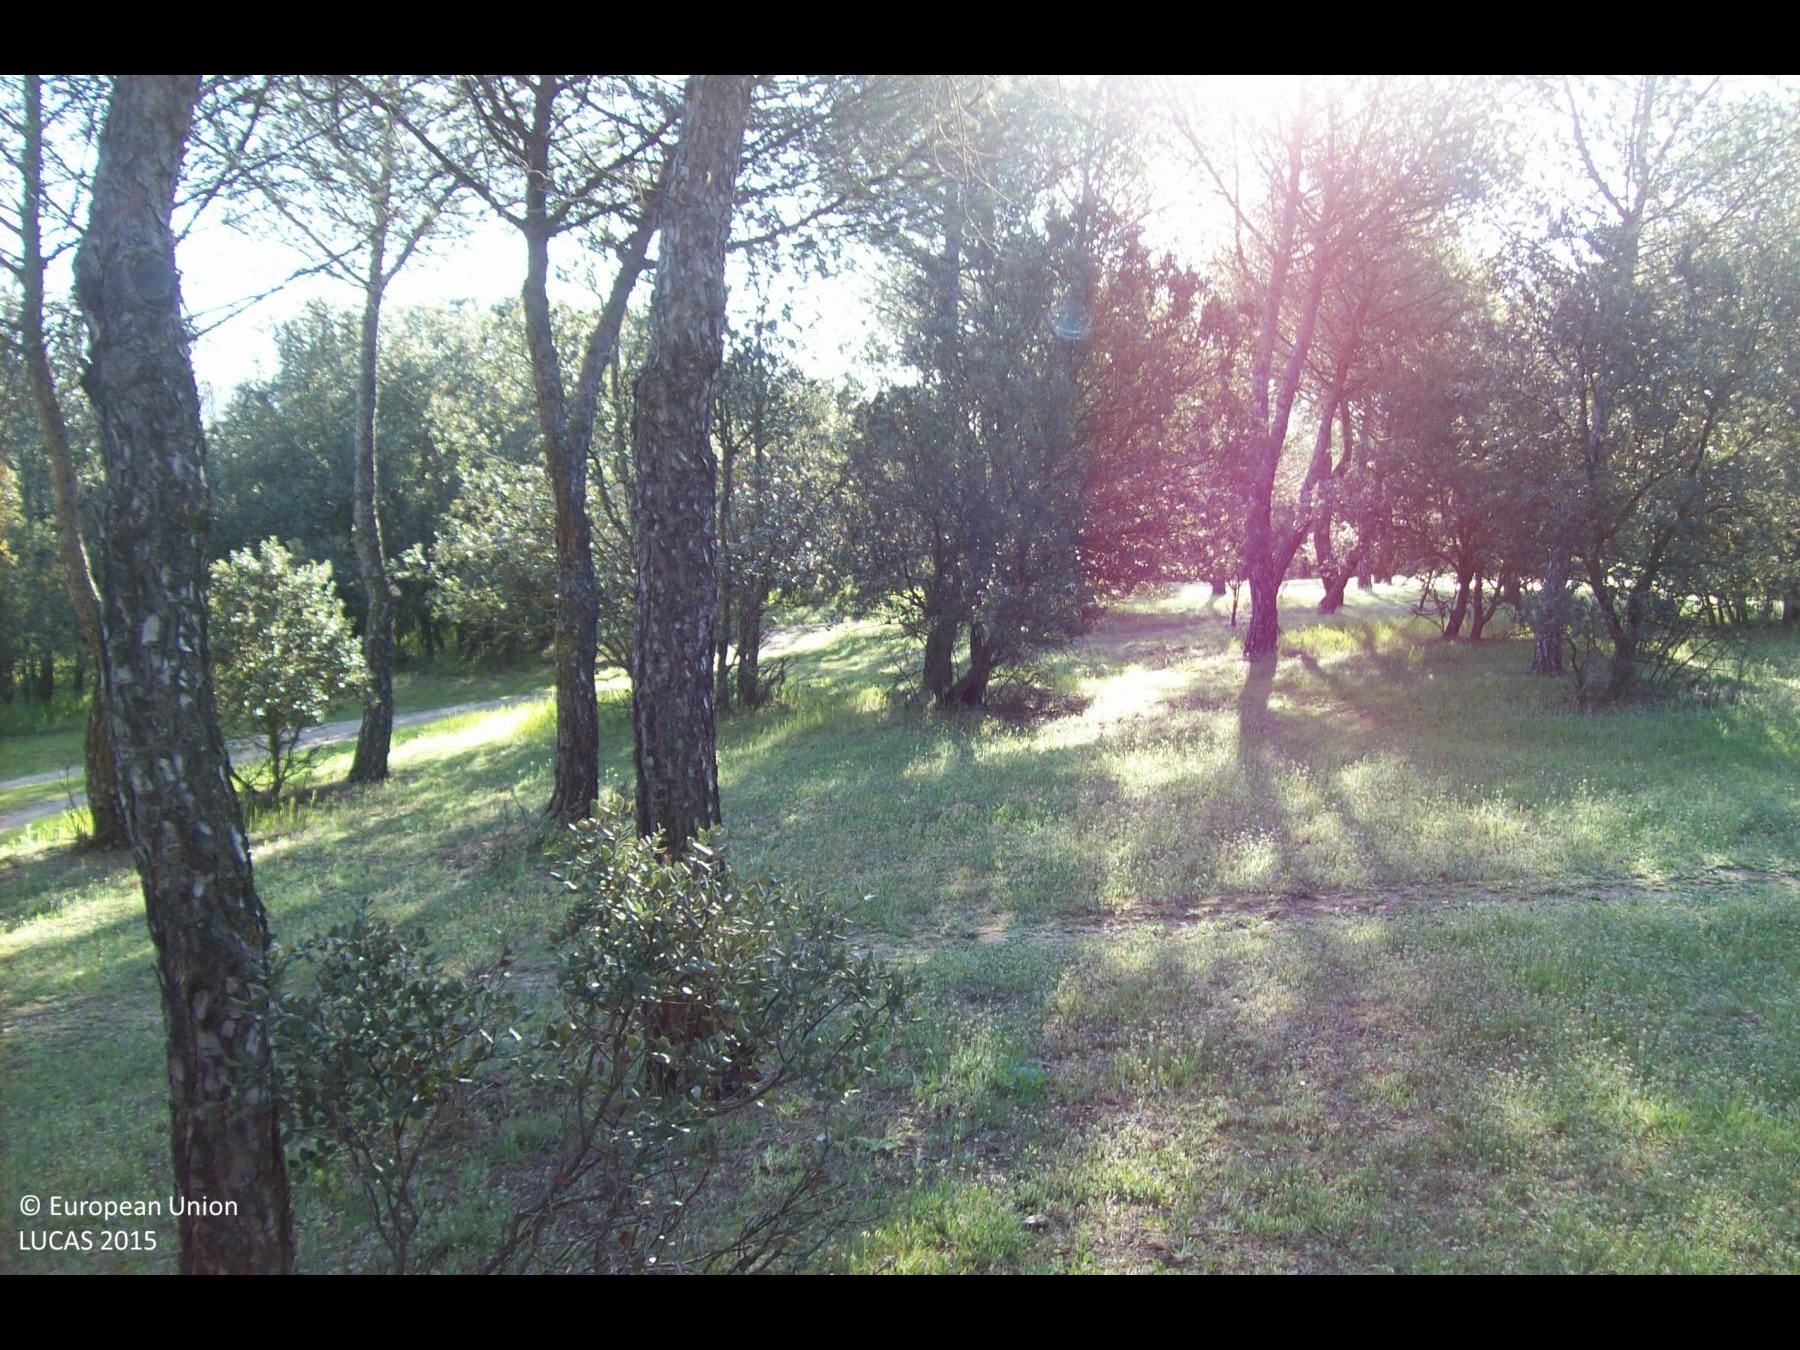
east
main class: Woodland
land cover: Pine dominated mixed woodland
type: coniferous forest of the mediterranean region
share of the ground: 50 - 75 %
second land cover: Grassland without tree/shrub cover
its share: > 75 %
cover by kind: coniferous forest trees 60 %, broadleaved forest trees 25 %, herbaceous plants 10 %
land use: Amenities, museums, leisure
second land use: Sport
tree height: < 5 m
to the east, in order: Pine dominated mixed woodland; Grassland without tree/shrub cover; Tracks; Pine dominated mixed woodland; Tracks; Pine dominated mixed woodland; Other mixed woodland; Tracks; Other mixed woodland
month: April
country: ES
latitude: 40.4304
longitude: -3.7473
